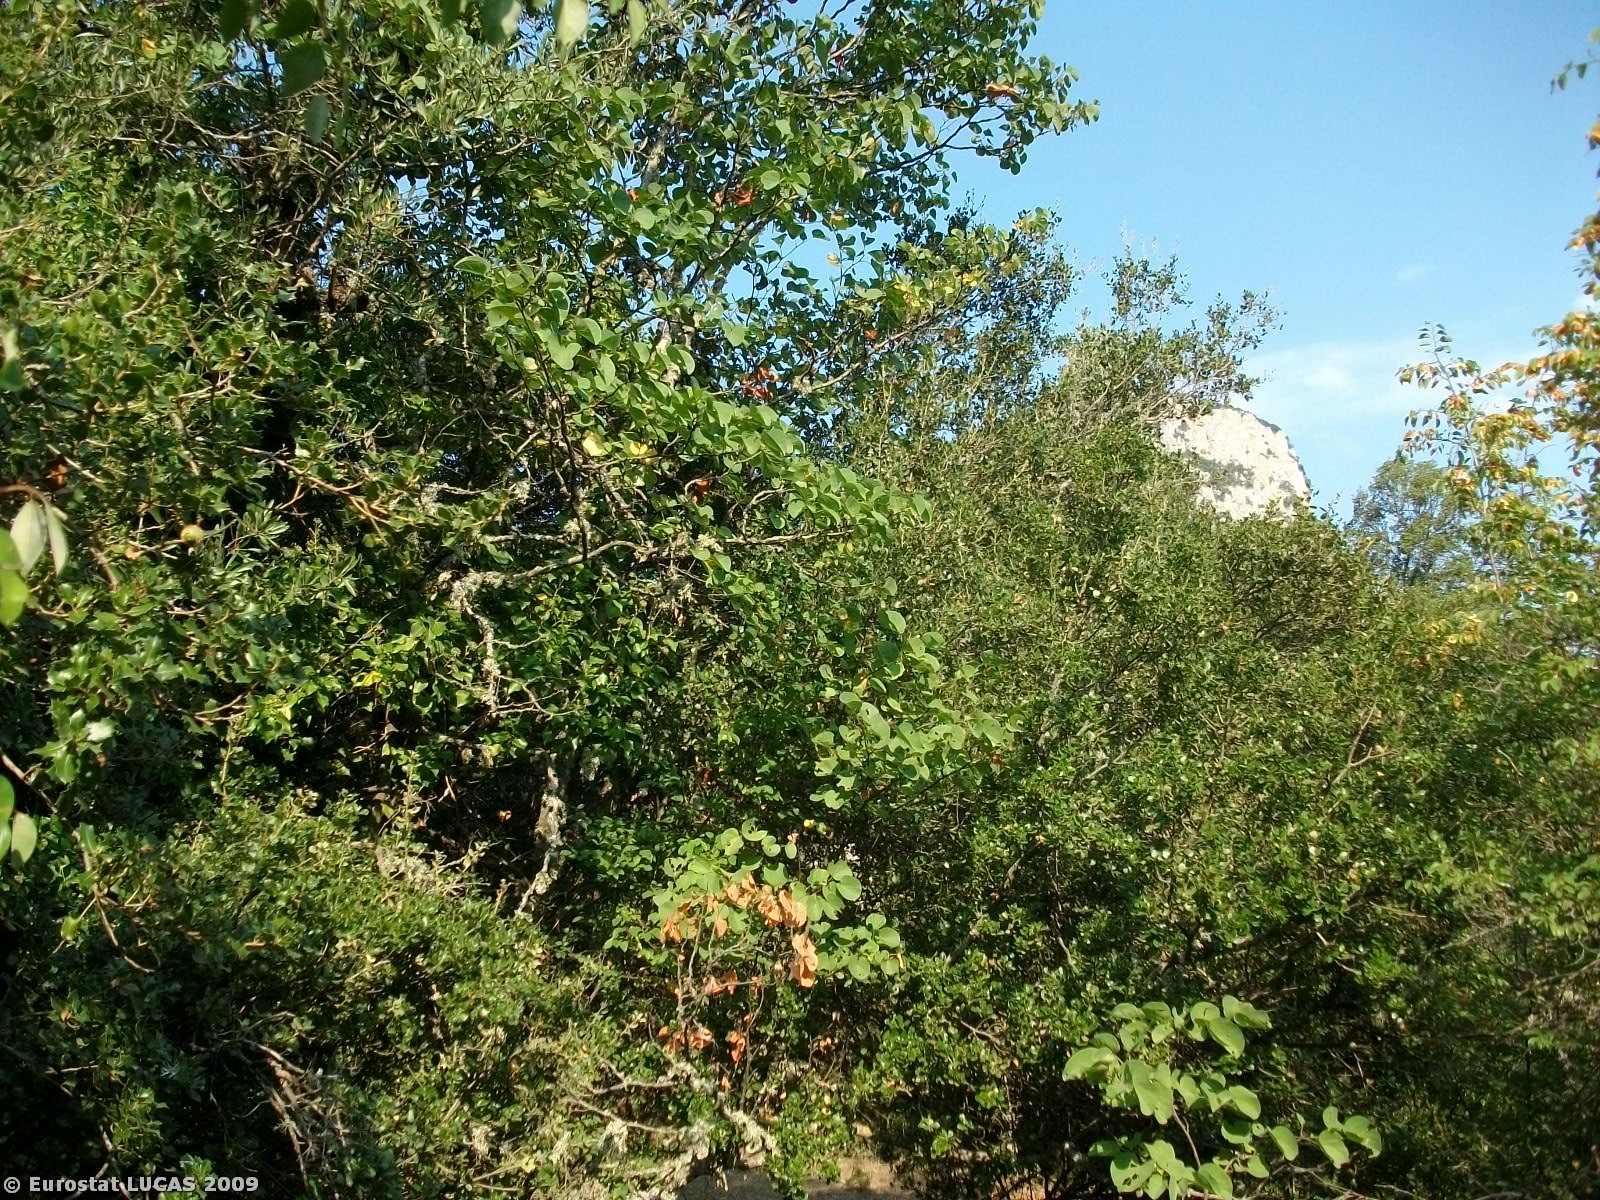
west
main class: Woodland
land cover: Broadleaved woodland
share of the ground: 50 - 75 %
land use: Forestry
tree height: < 5 m
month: August
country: GR
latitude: 38.7615
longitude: 22.4191
